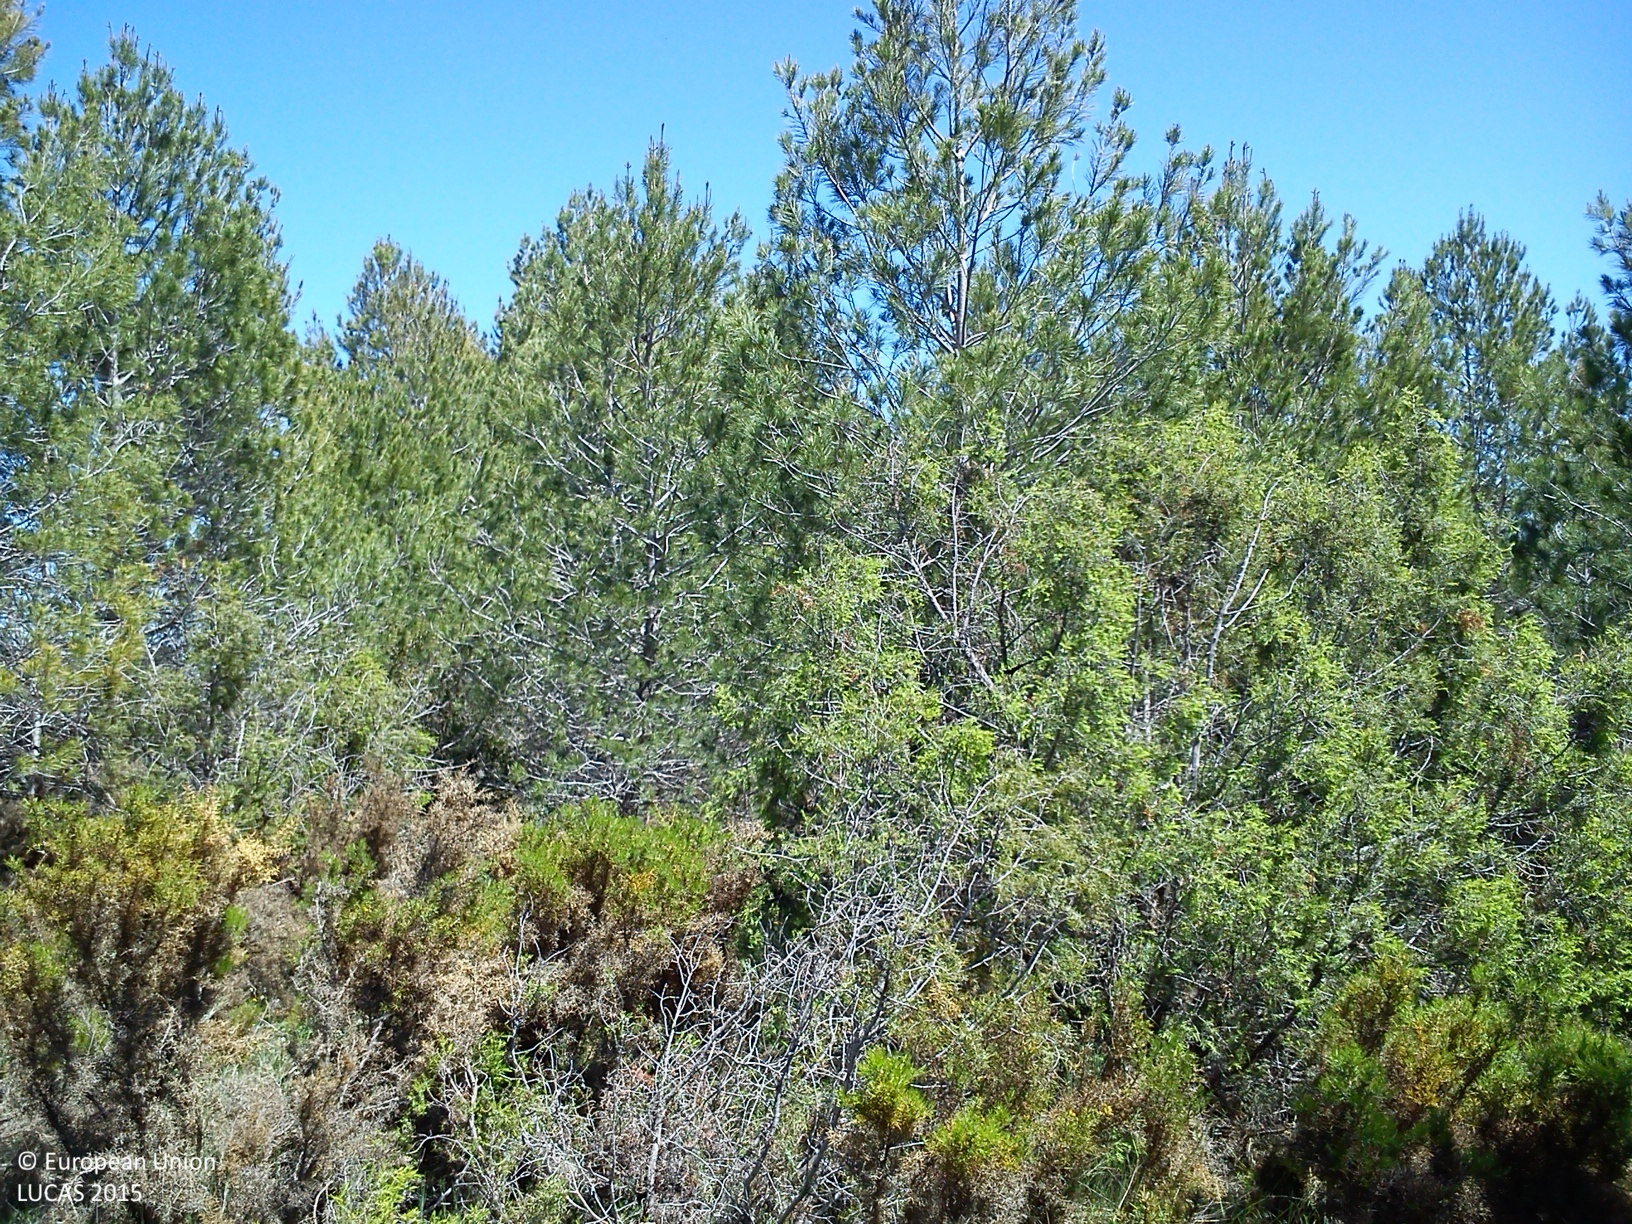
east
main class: Woodland
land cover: Pine dominated coniferous woodland
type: coniferous forest of the mediterranean region
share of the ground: > 75 %
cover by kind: shrubs 55 %, coniferous forest trees 35 %, herbaceous plants 10 %
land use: Semi-natural and natural areas not in use
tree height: > 5 m
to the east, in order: Pine dominated coniferous woodland; Shrubland with sparse tree cover; Tracks; Shrubland with sparse tree cover; Pine dominated coniferous woodland; Grassland with sparse tree/shrub cover
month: May
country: ES
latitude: 39.5660
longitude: -0.9077
